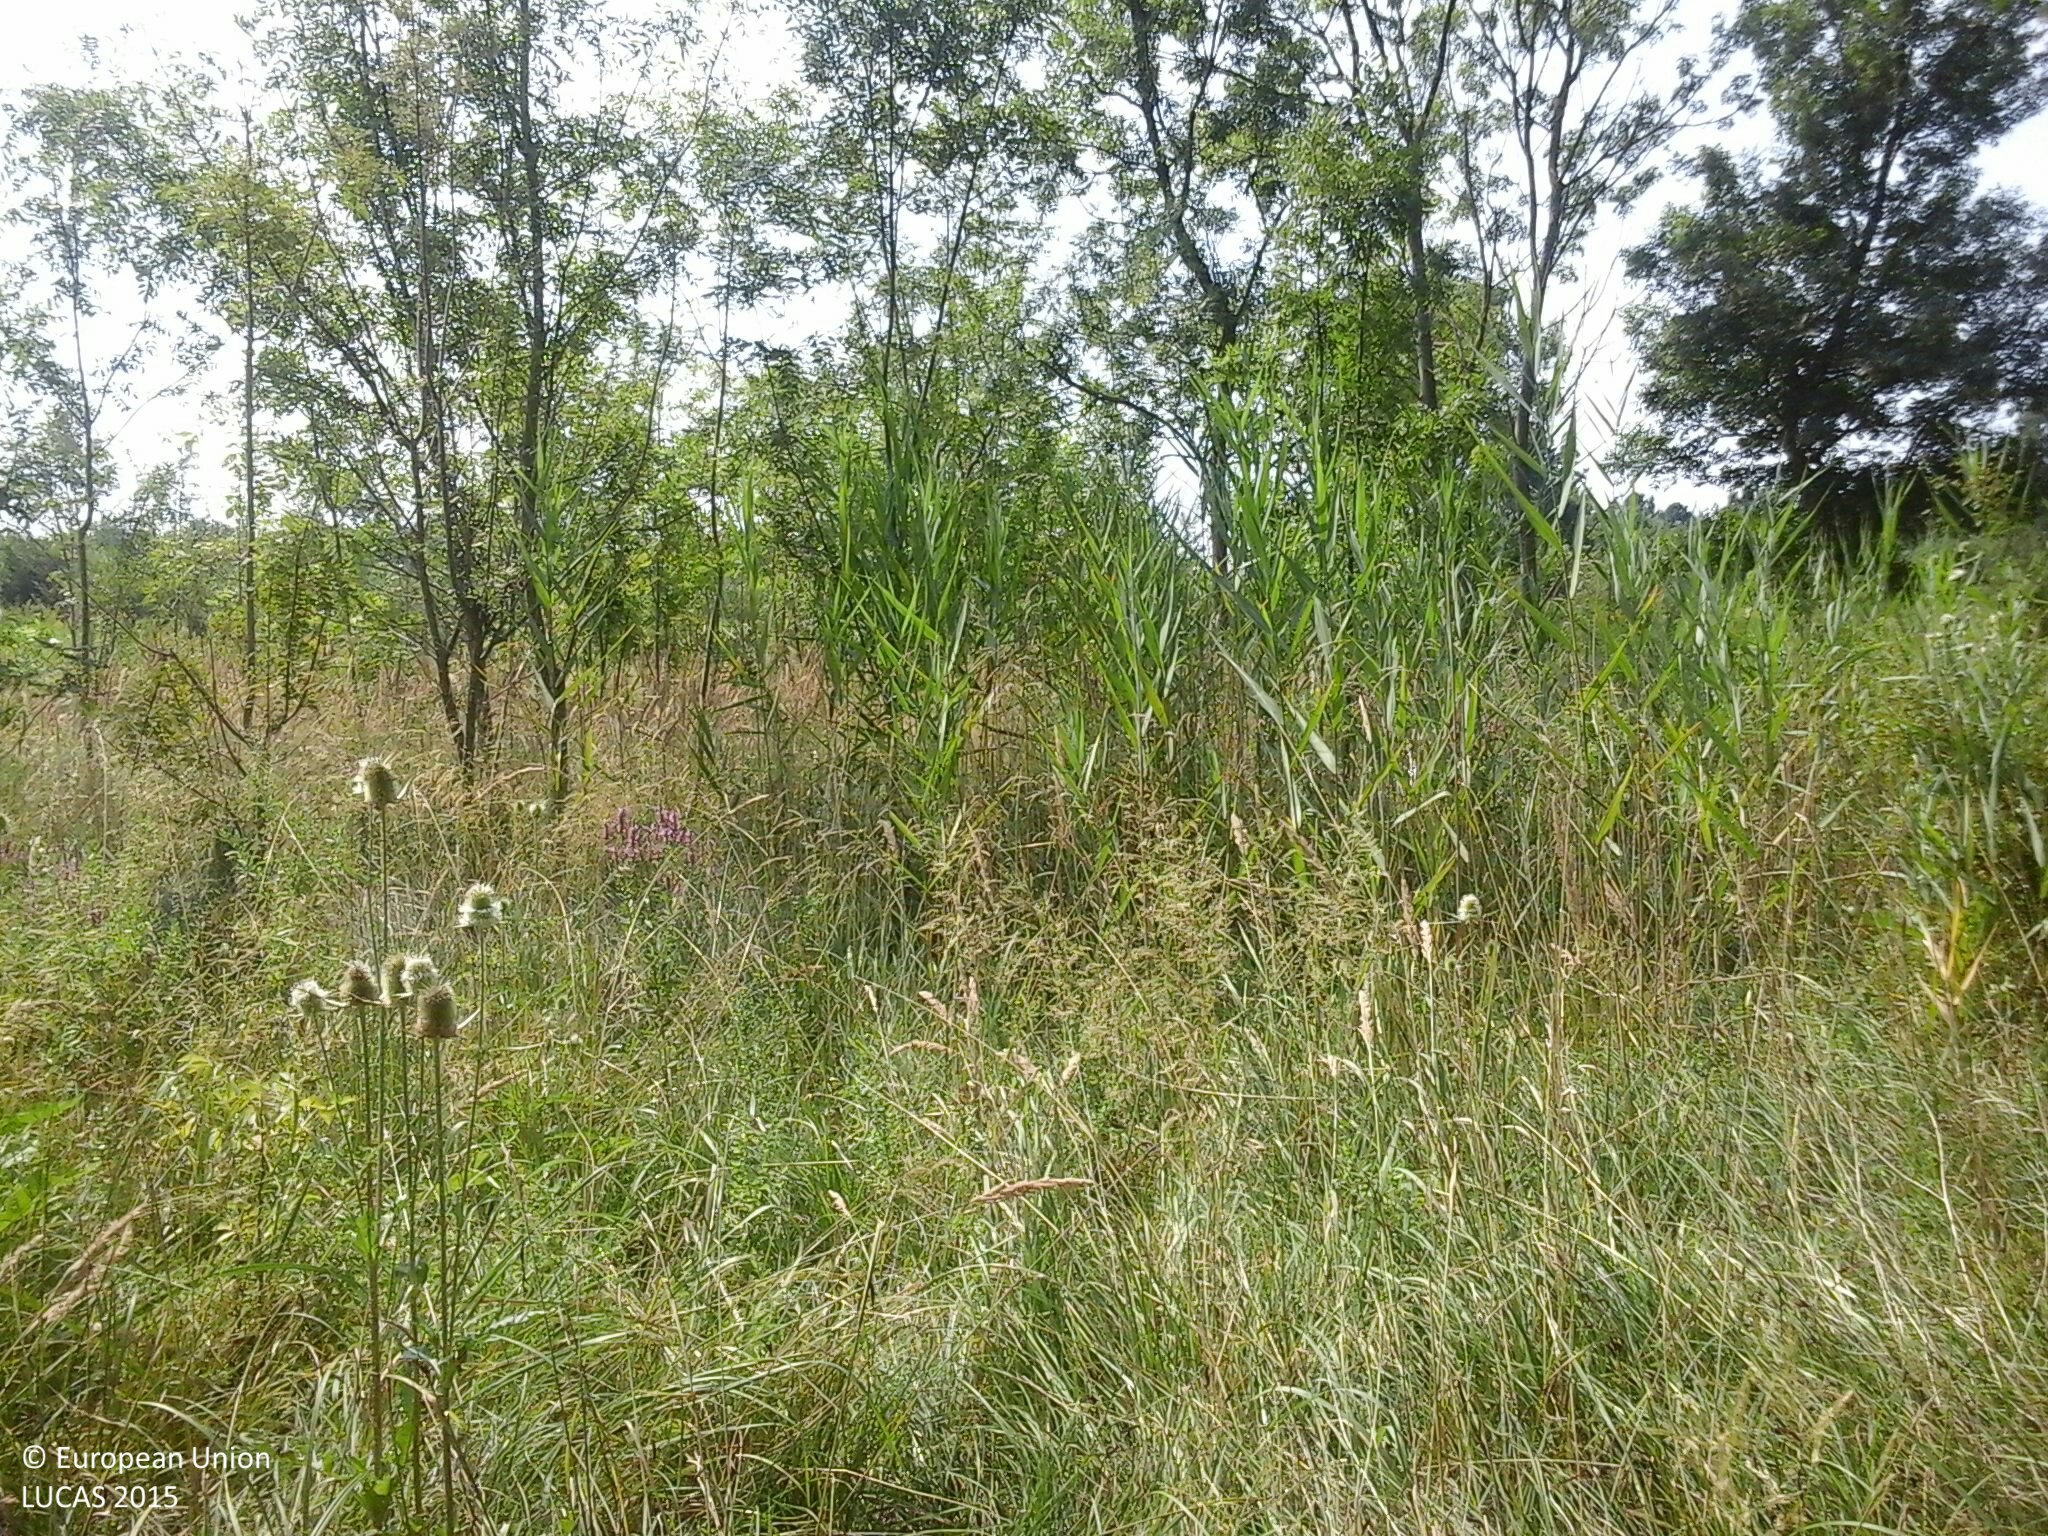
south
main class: Woodland
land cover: Broadleaved woodland
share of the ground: 25 - 50 %
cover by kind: herbaceous plants 60 %, broadleaved forest trees 40 %
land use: Abandoned areas
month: August
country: HU
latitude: 46.0391
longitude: 18.1601
